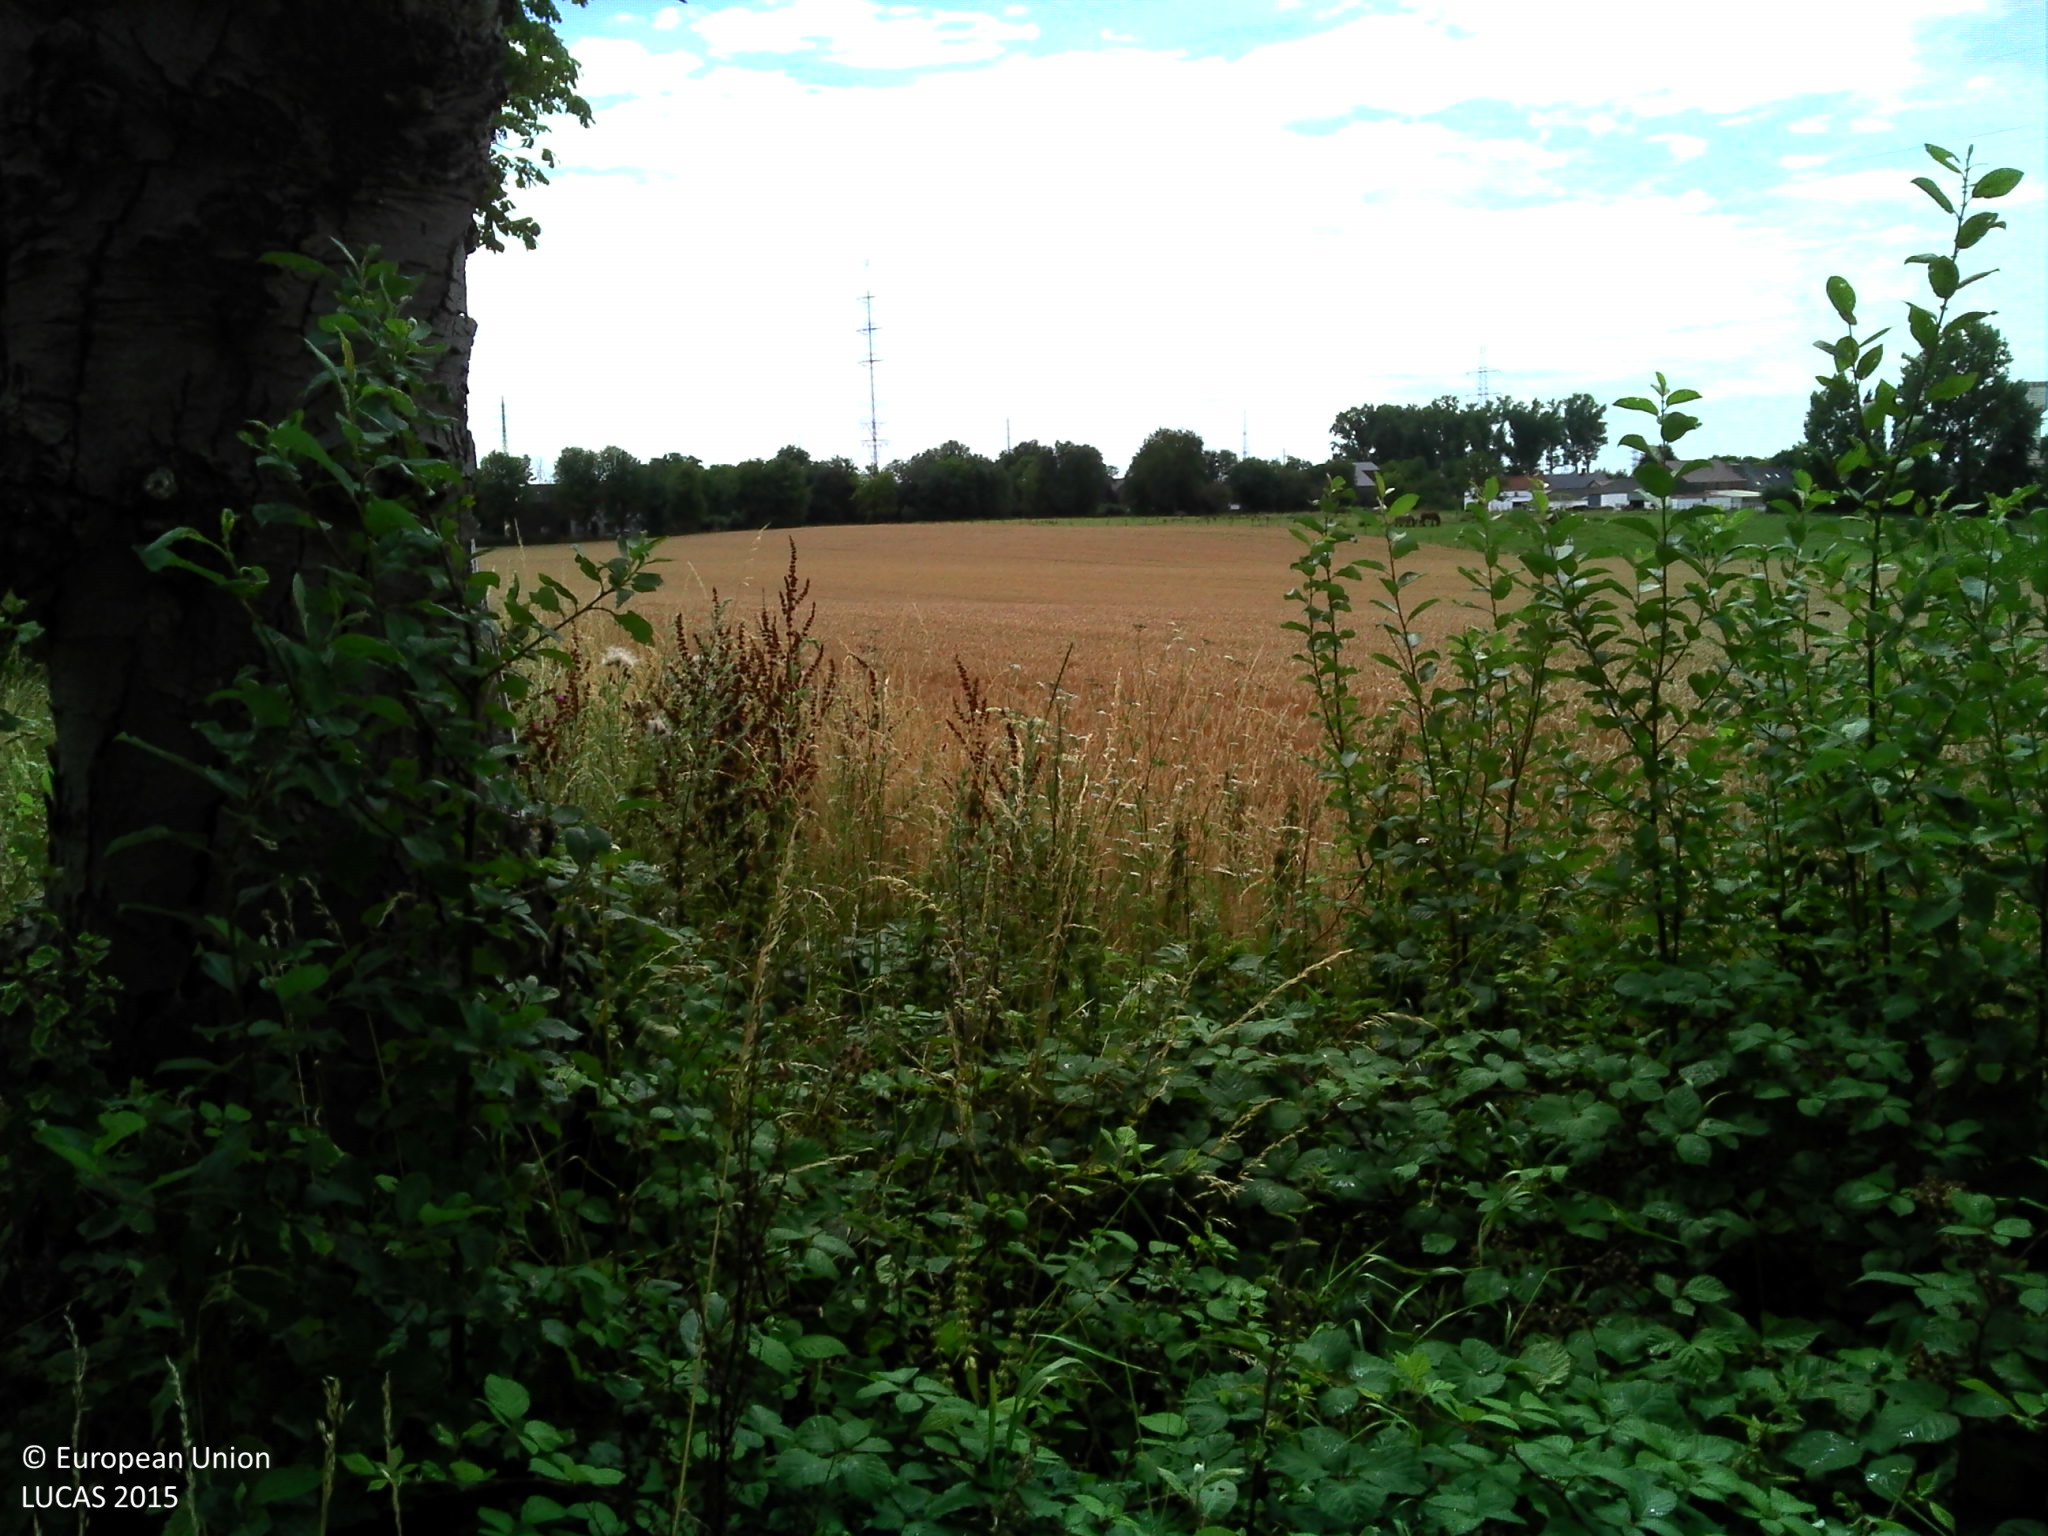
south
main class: Woodland
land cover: Broadleaved woodland
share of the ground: > 75 %
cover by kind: broadleaved forest trees 60 %, herbaceous plants 40 %
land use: Semi-natural and natural areas not in use
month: July
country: BE
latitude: 50.4945
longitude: 4.3426
